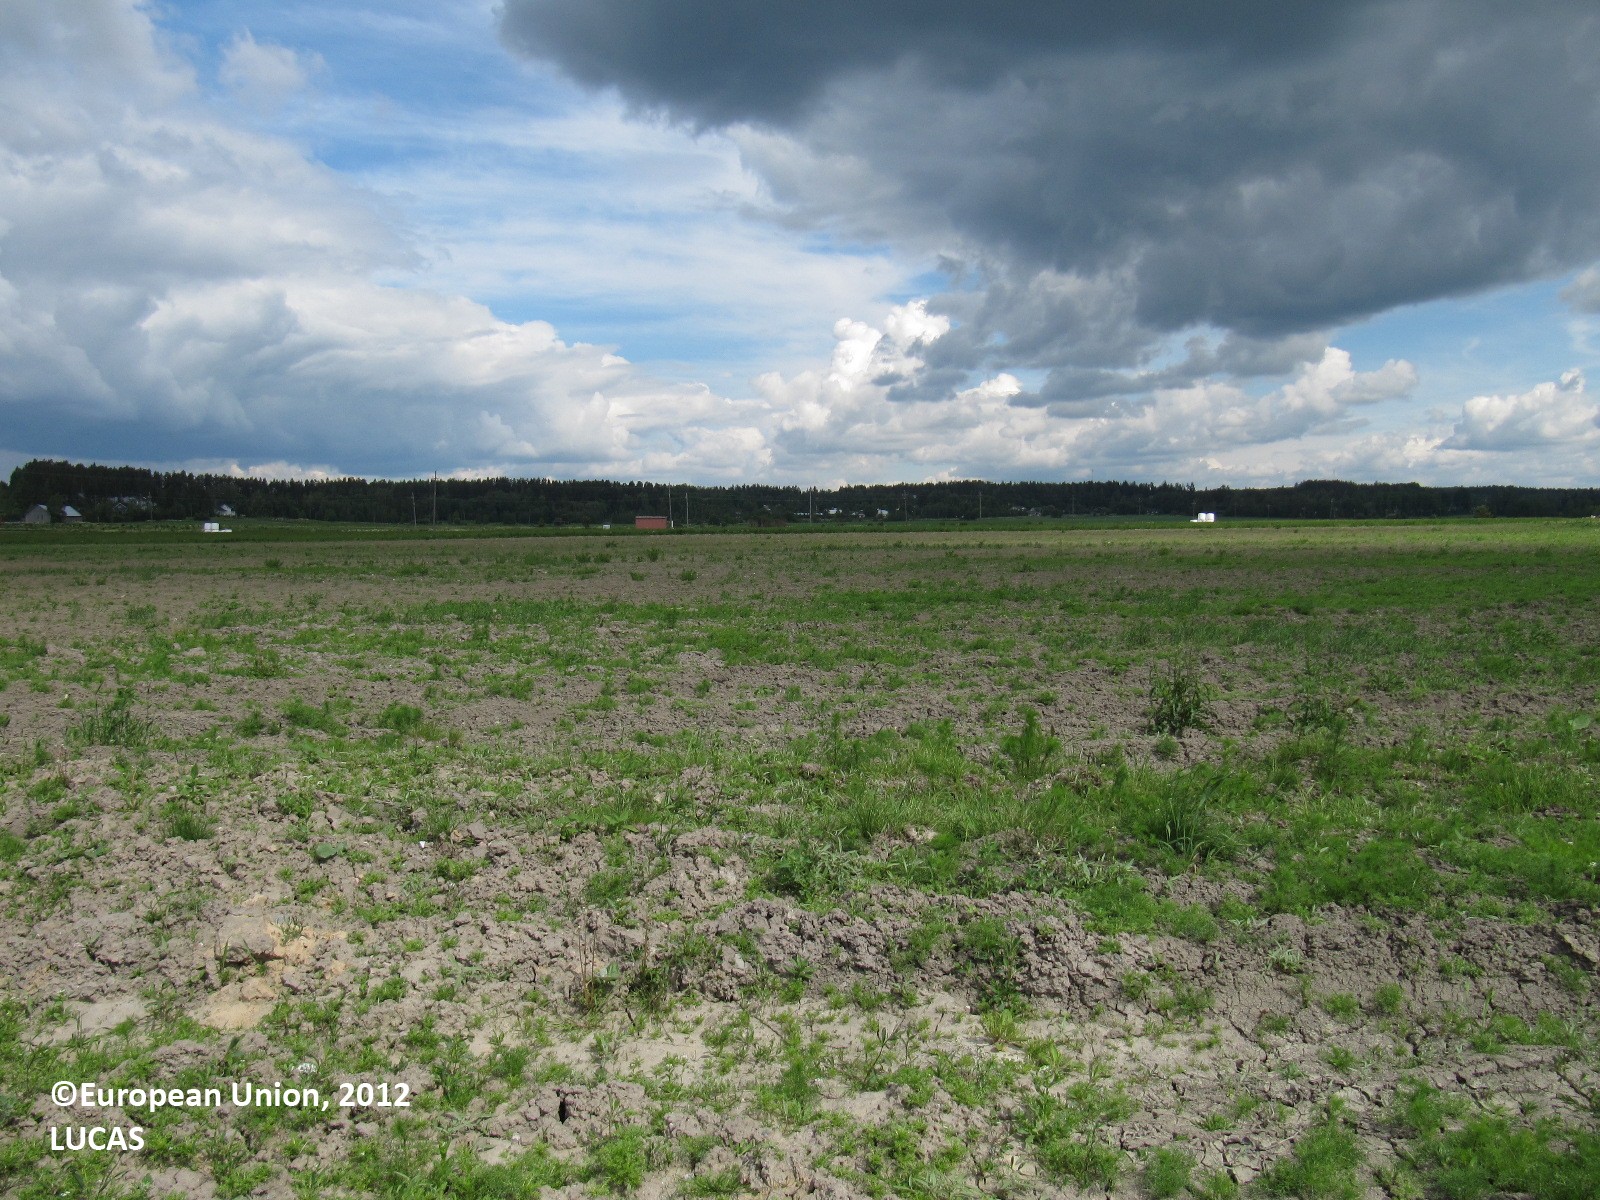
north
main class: Cropland
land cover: Other non-permanent industrial crops
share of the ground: 25 - 50 %
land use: Fallow land
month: June
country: FI
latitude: 60.3567
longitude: 24.3695
